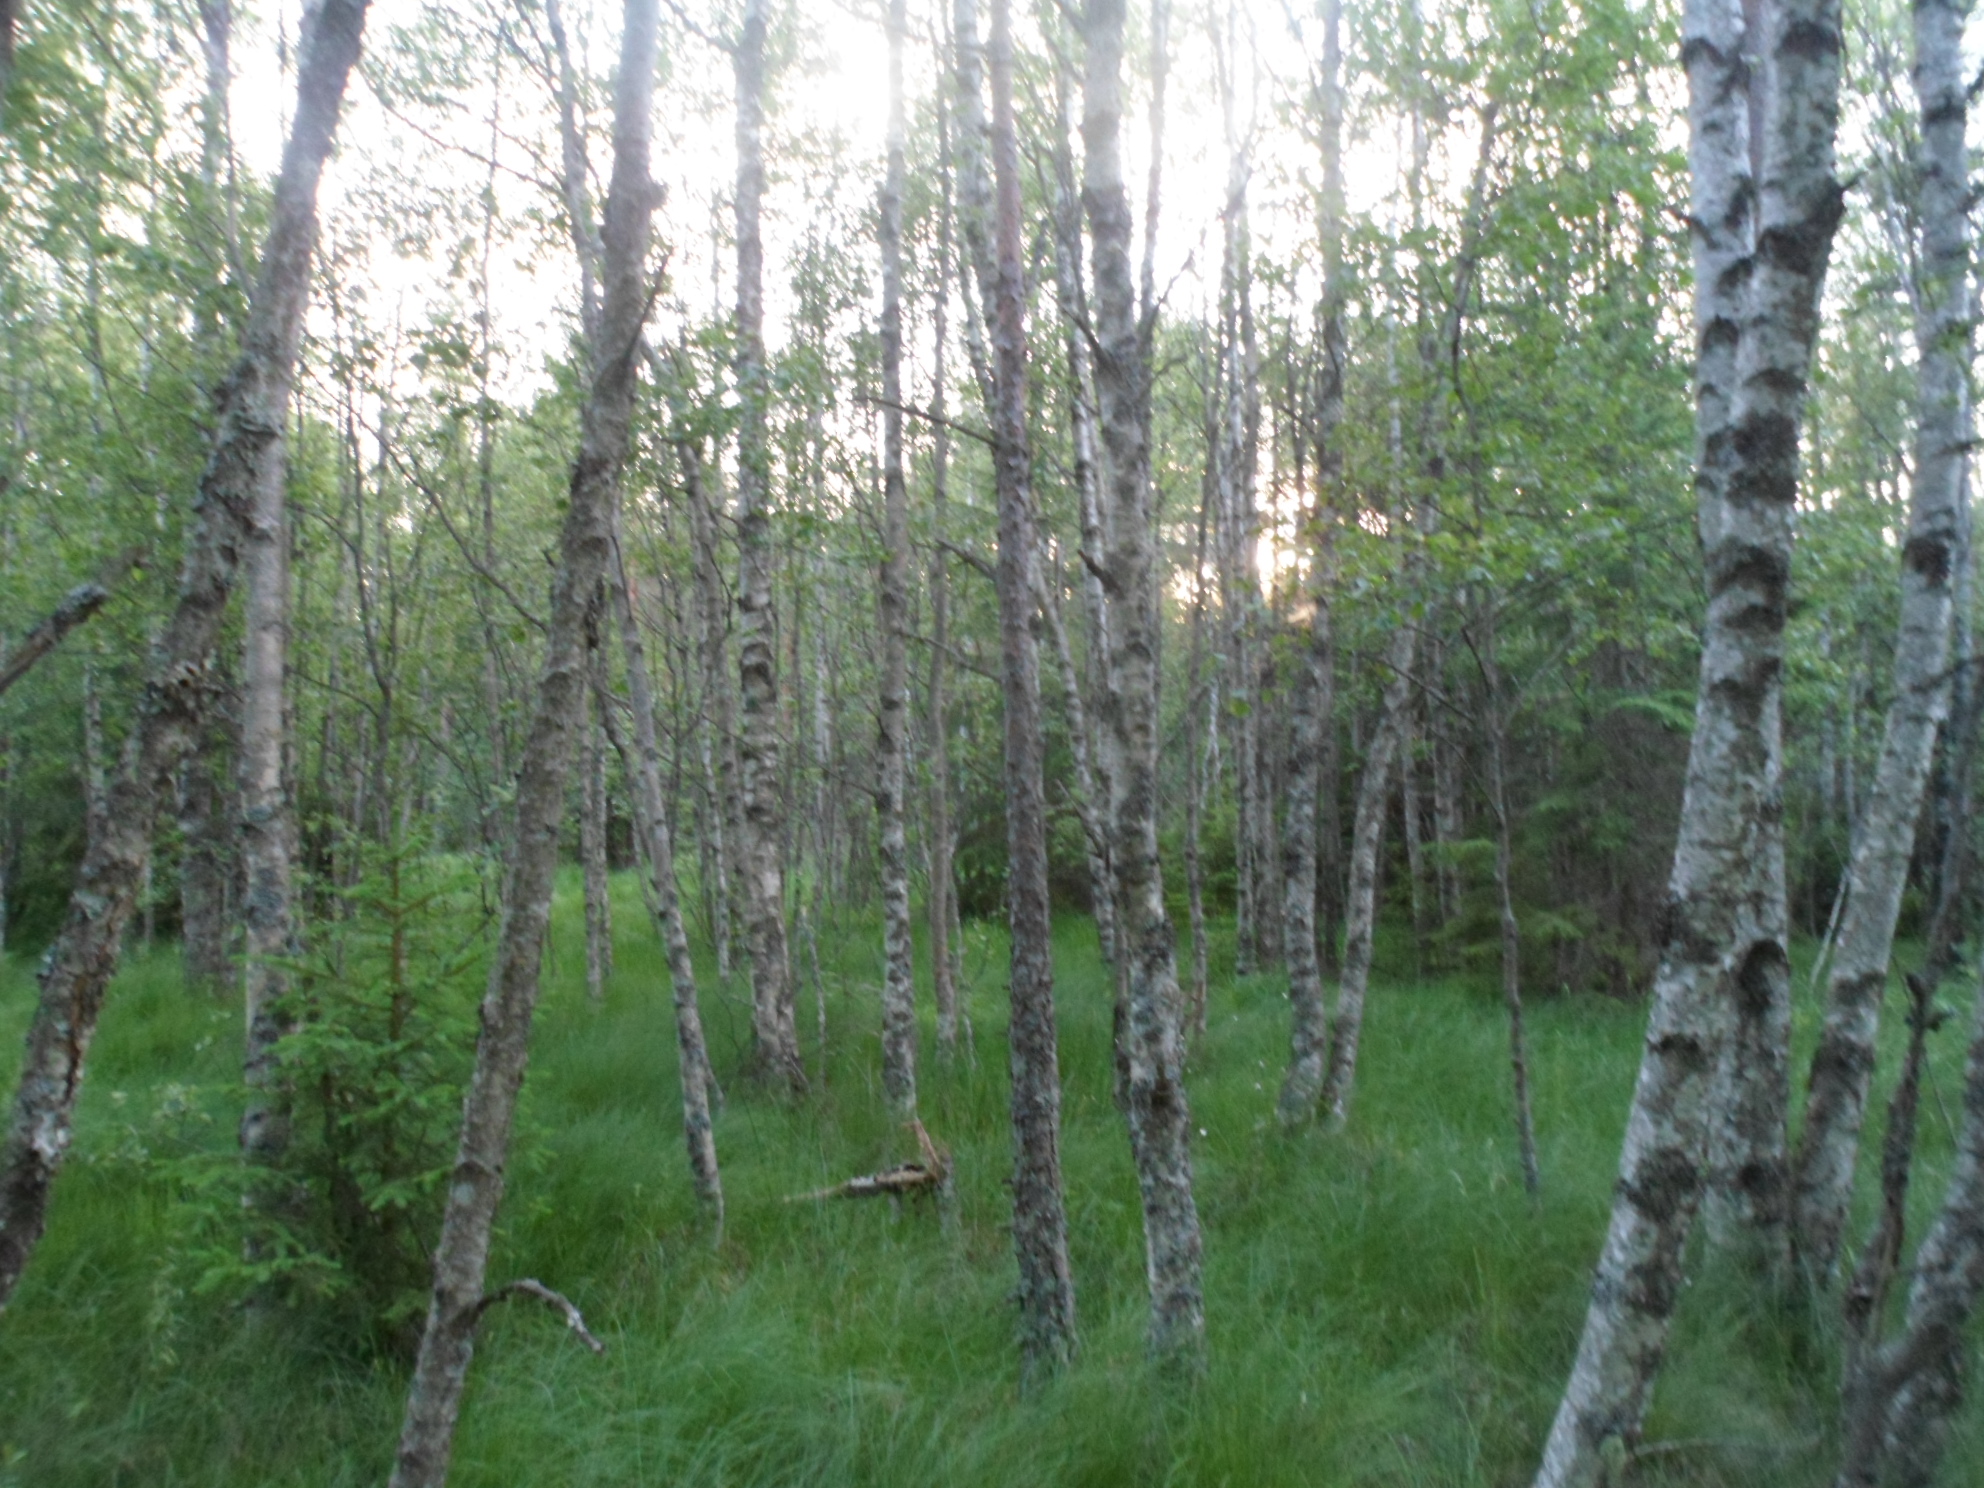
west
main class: Woodland
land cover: Broadleaved woodland
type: mire and swamp forests
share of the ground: 50 - 75 %
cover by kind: broadleaved forest trees 60 %, herbaceous plants 25 %, lichens and mosses 10 %, shrubs 5 %
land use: Forestry
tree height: > 5 m
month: June
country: SE
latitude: 57.1044
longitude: 15.3298
